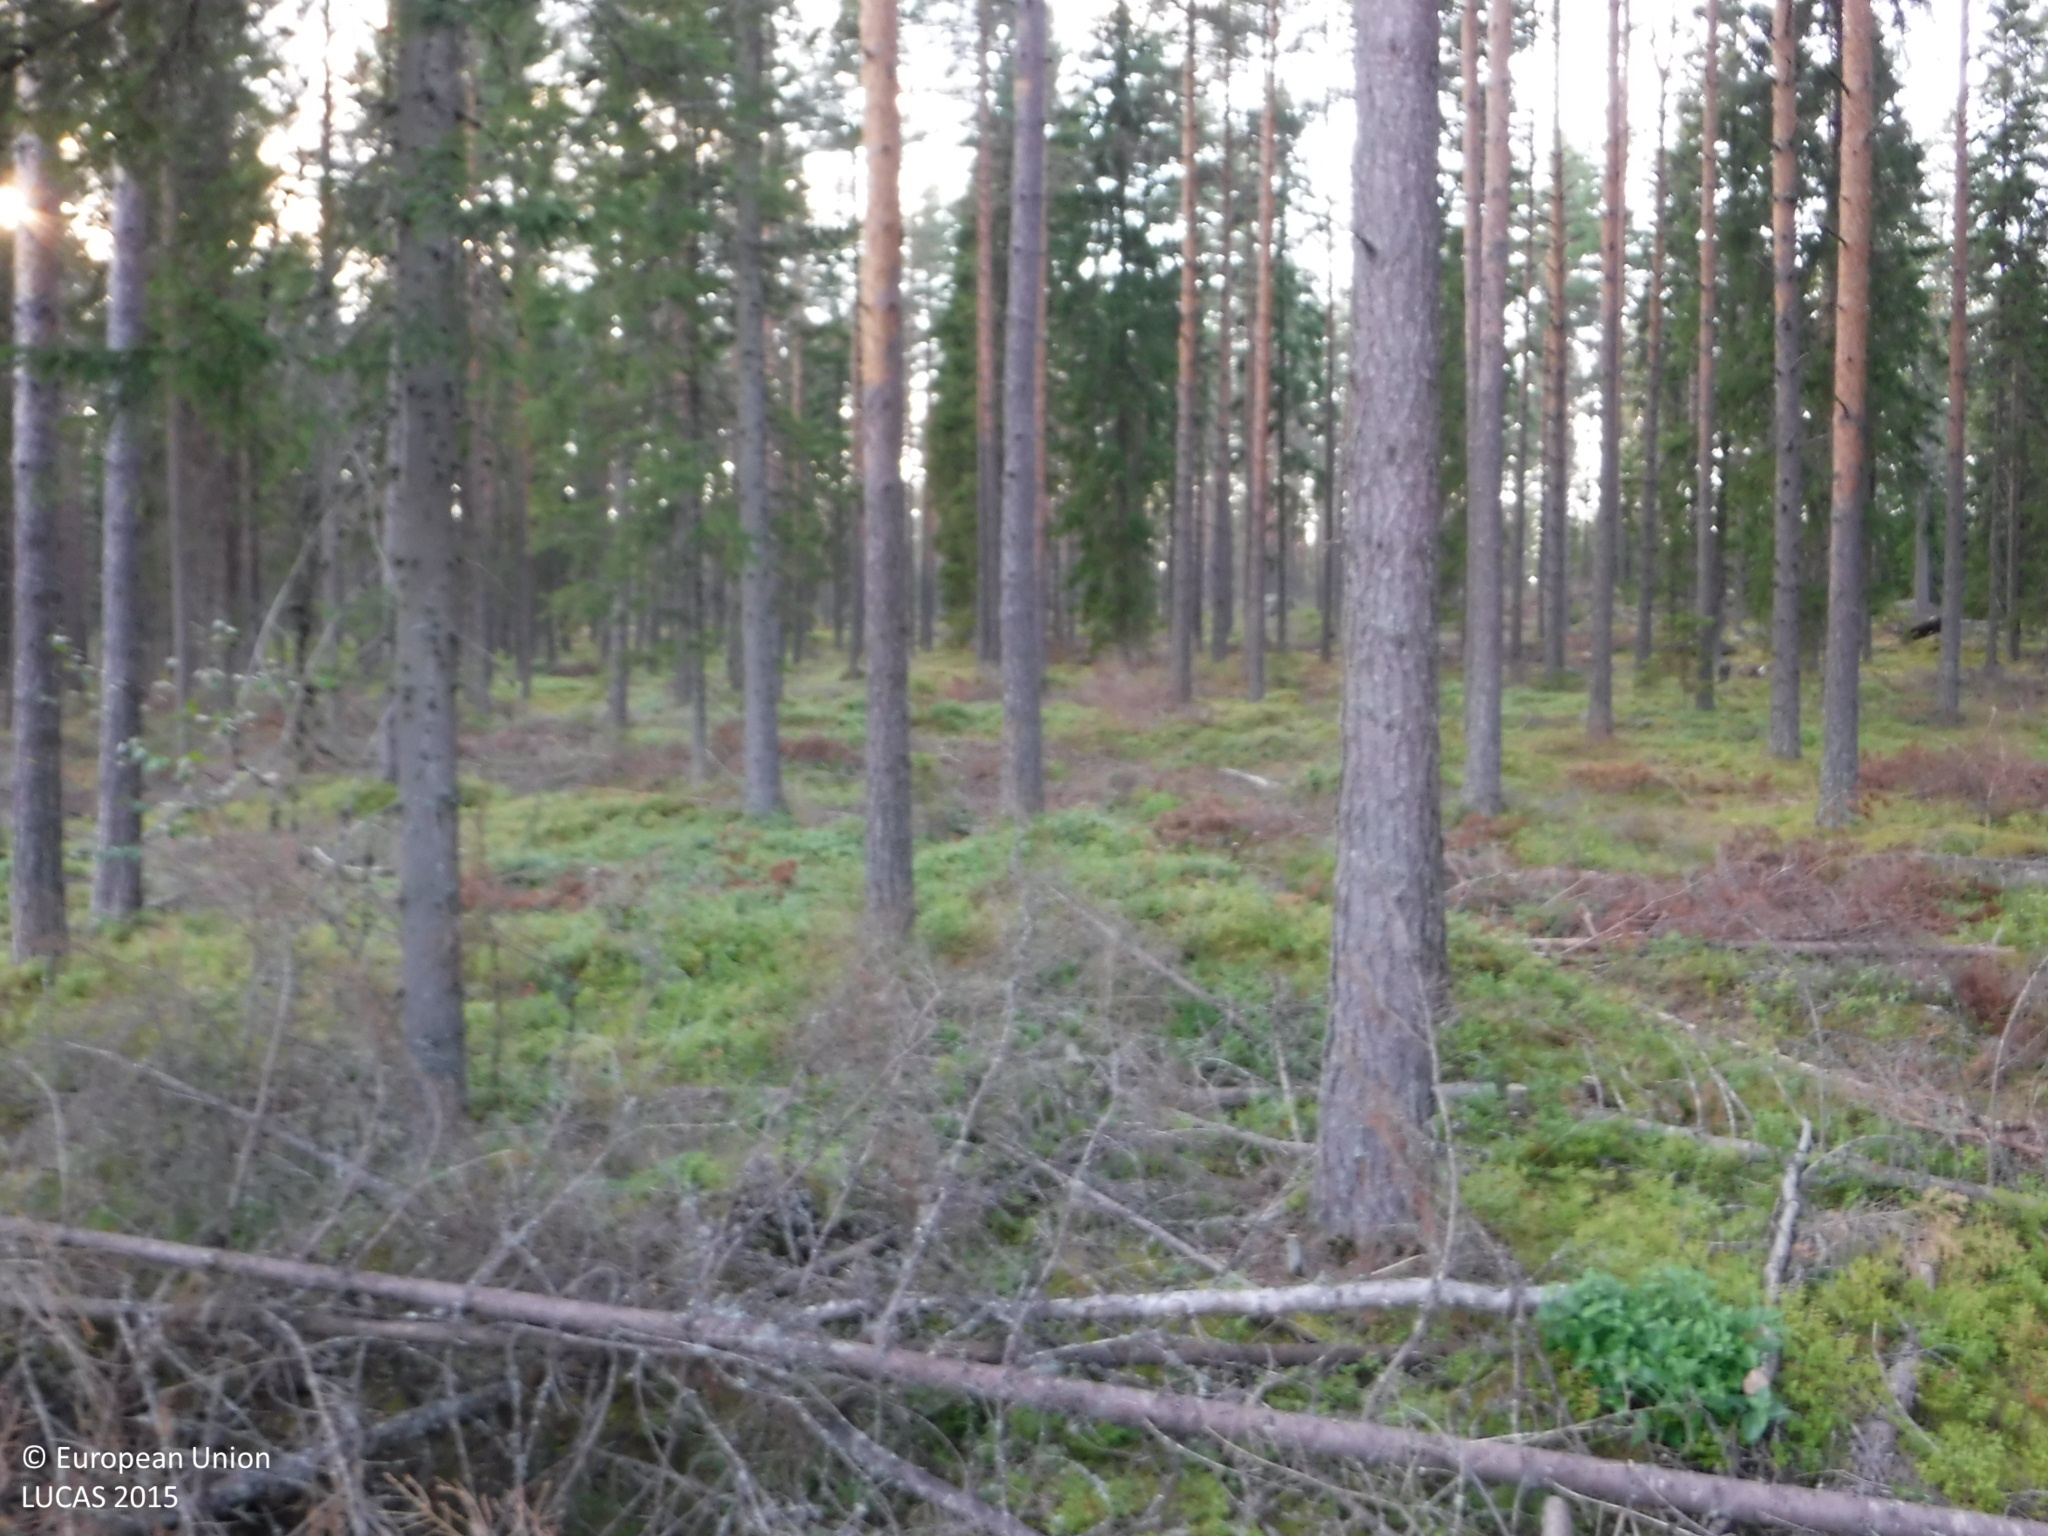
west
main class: Woodland
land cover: Other coniferous woodland
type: boreal forest
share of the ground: 25 - 50 %
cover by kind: coniferous forest trees 50 %, shrubs 30 %, lichens and mosses 20 %
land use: Forestry
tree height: > 5 m
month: August
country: FI
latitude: 61.1610
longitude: 23.0654
